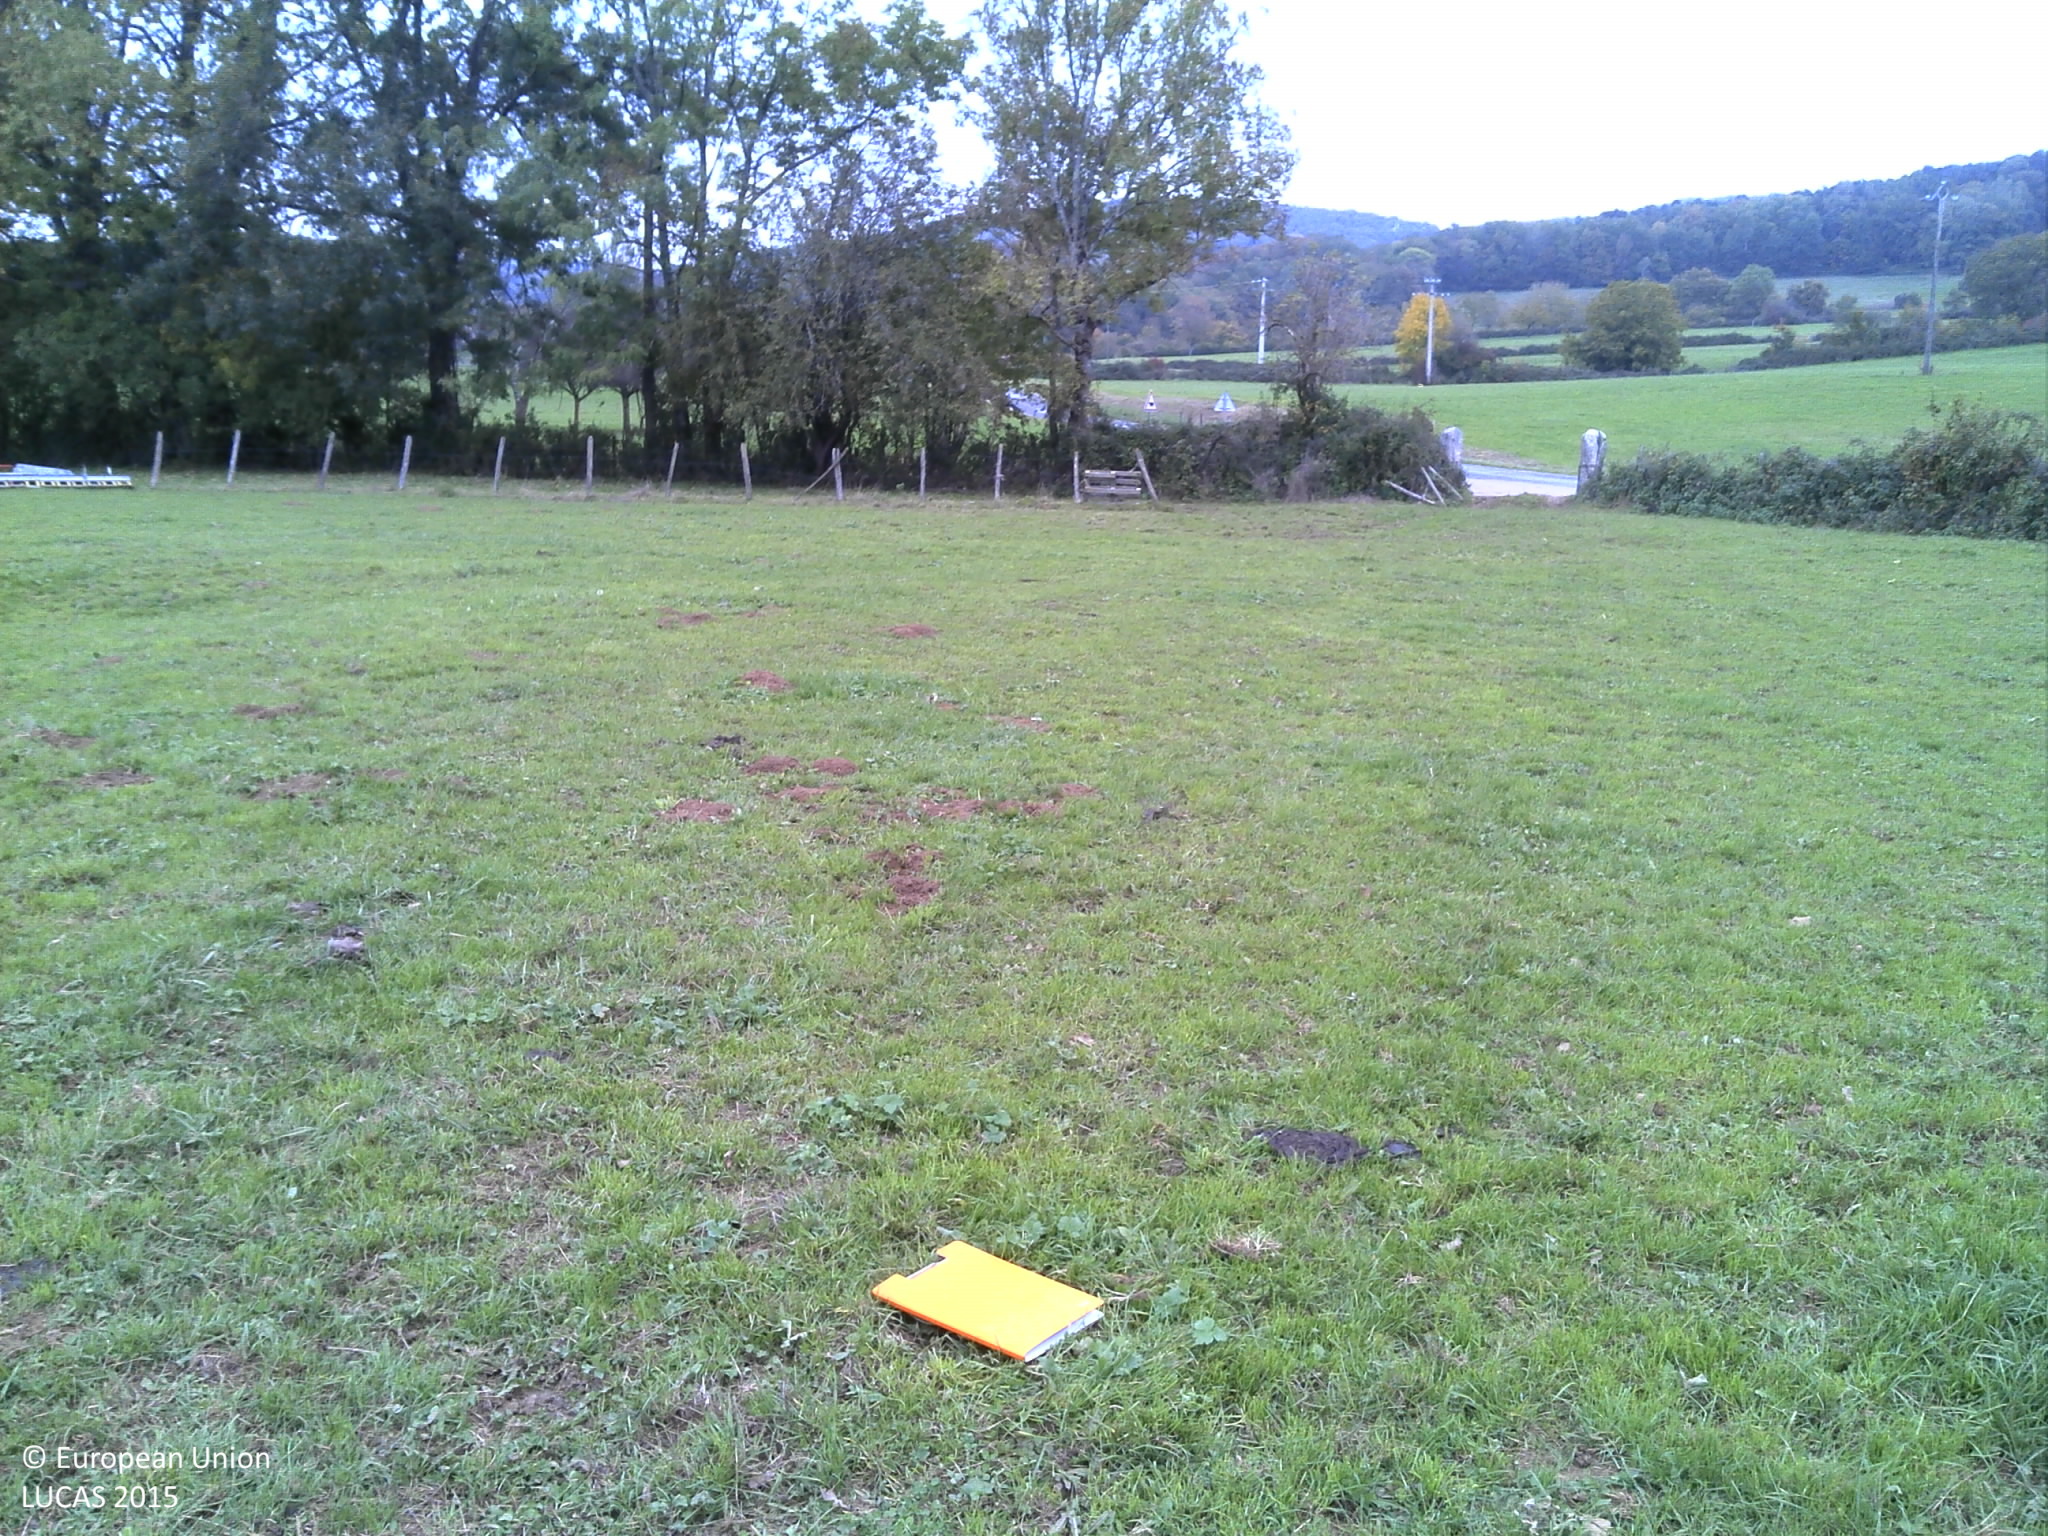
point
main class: Grassland
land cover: Grassland without tree/shrub cover
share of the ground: > 75 %
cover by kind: herbaceous plants 100 %
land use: Agriculture (excluding fallow land and kitchen gardens)
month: October
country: FR
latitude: 46.0904
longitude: 5.4120
